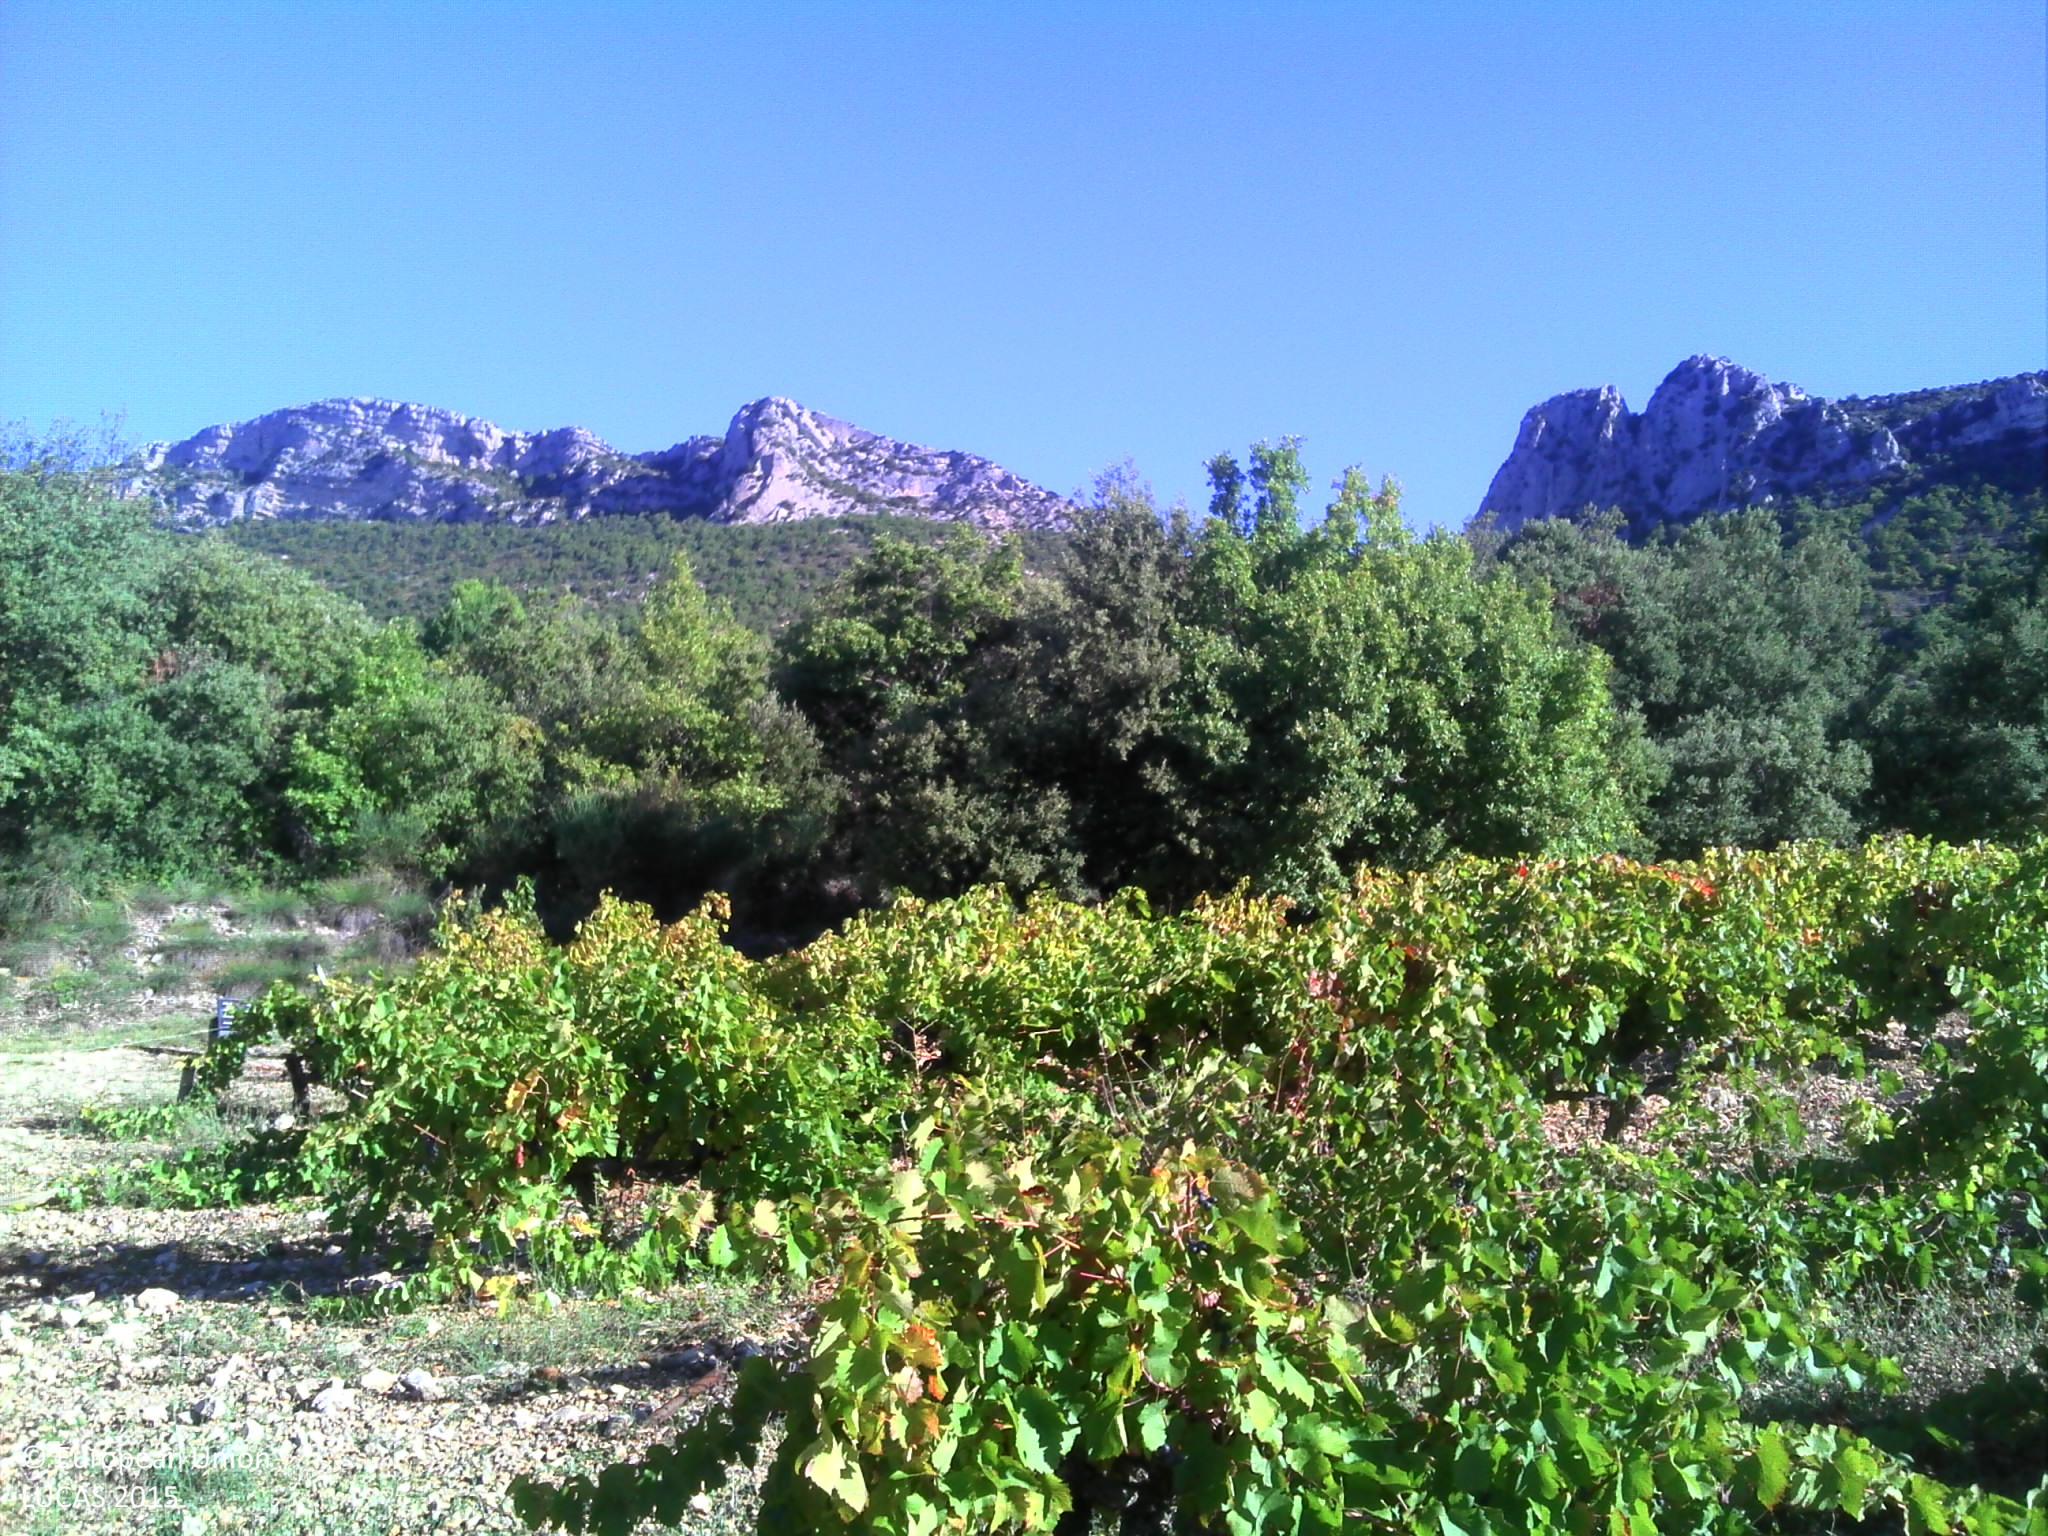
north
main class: Cropland
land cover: Vineyards
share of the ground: 25 - 50 %
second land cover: Other bare soil
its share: > 75 %
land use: Agriculture (excluding fallow land and kitchen gardens)
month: September
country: FR
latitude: 44.2952
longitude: 5.2324
